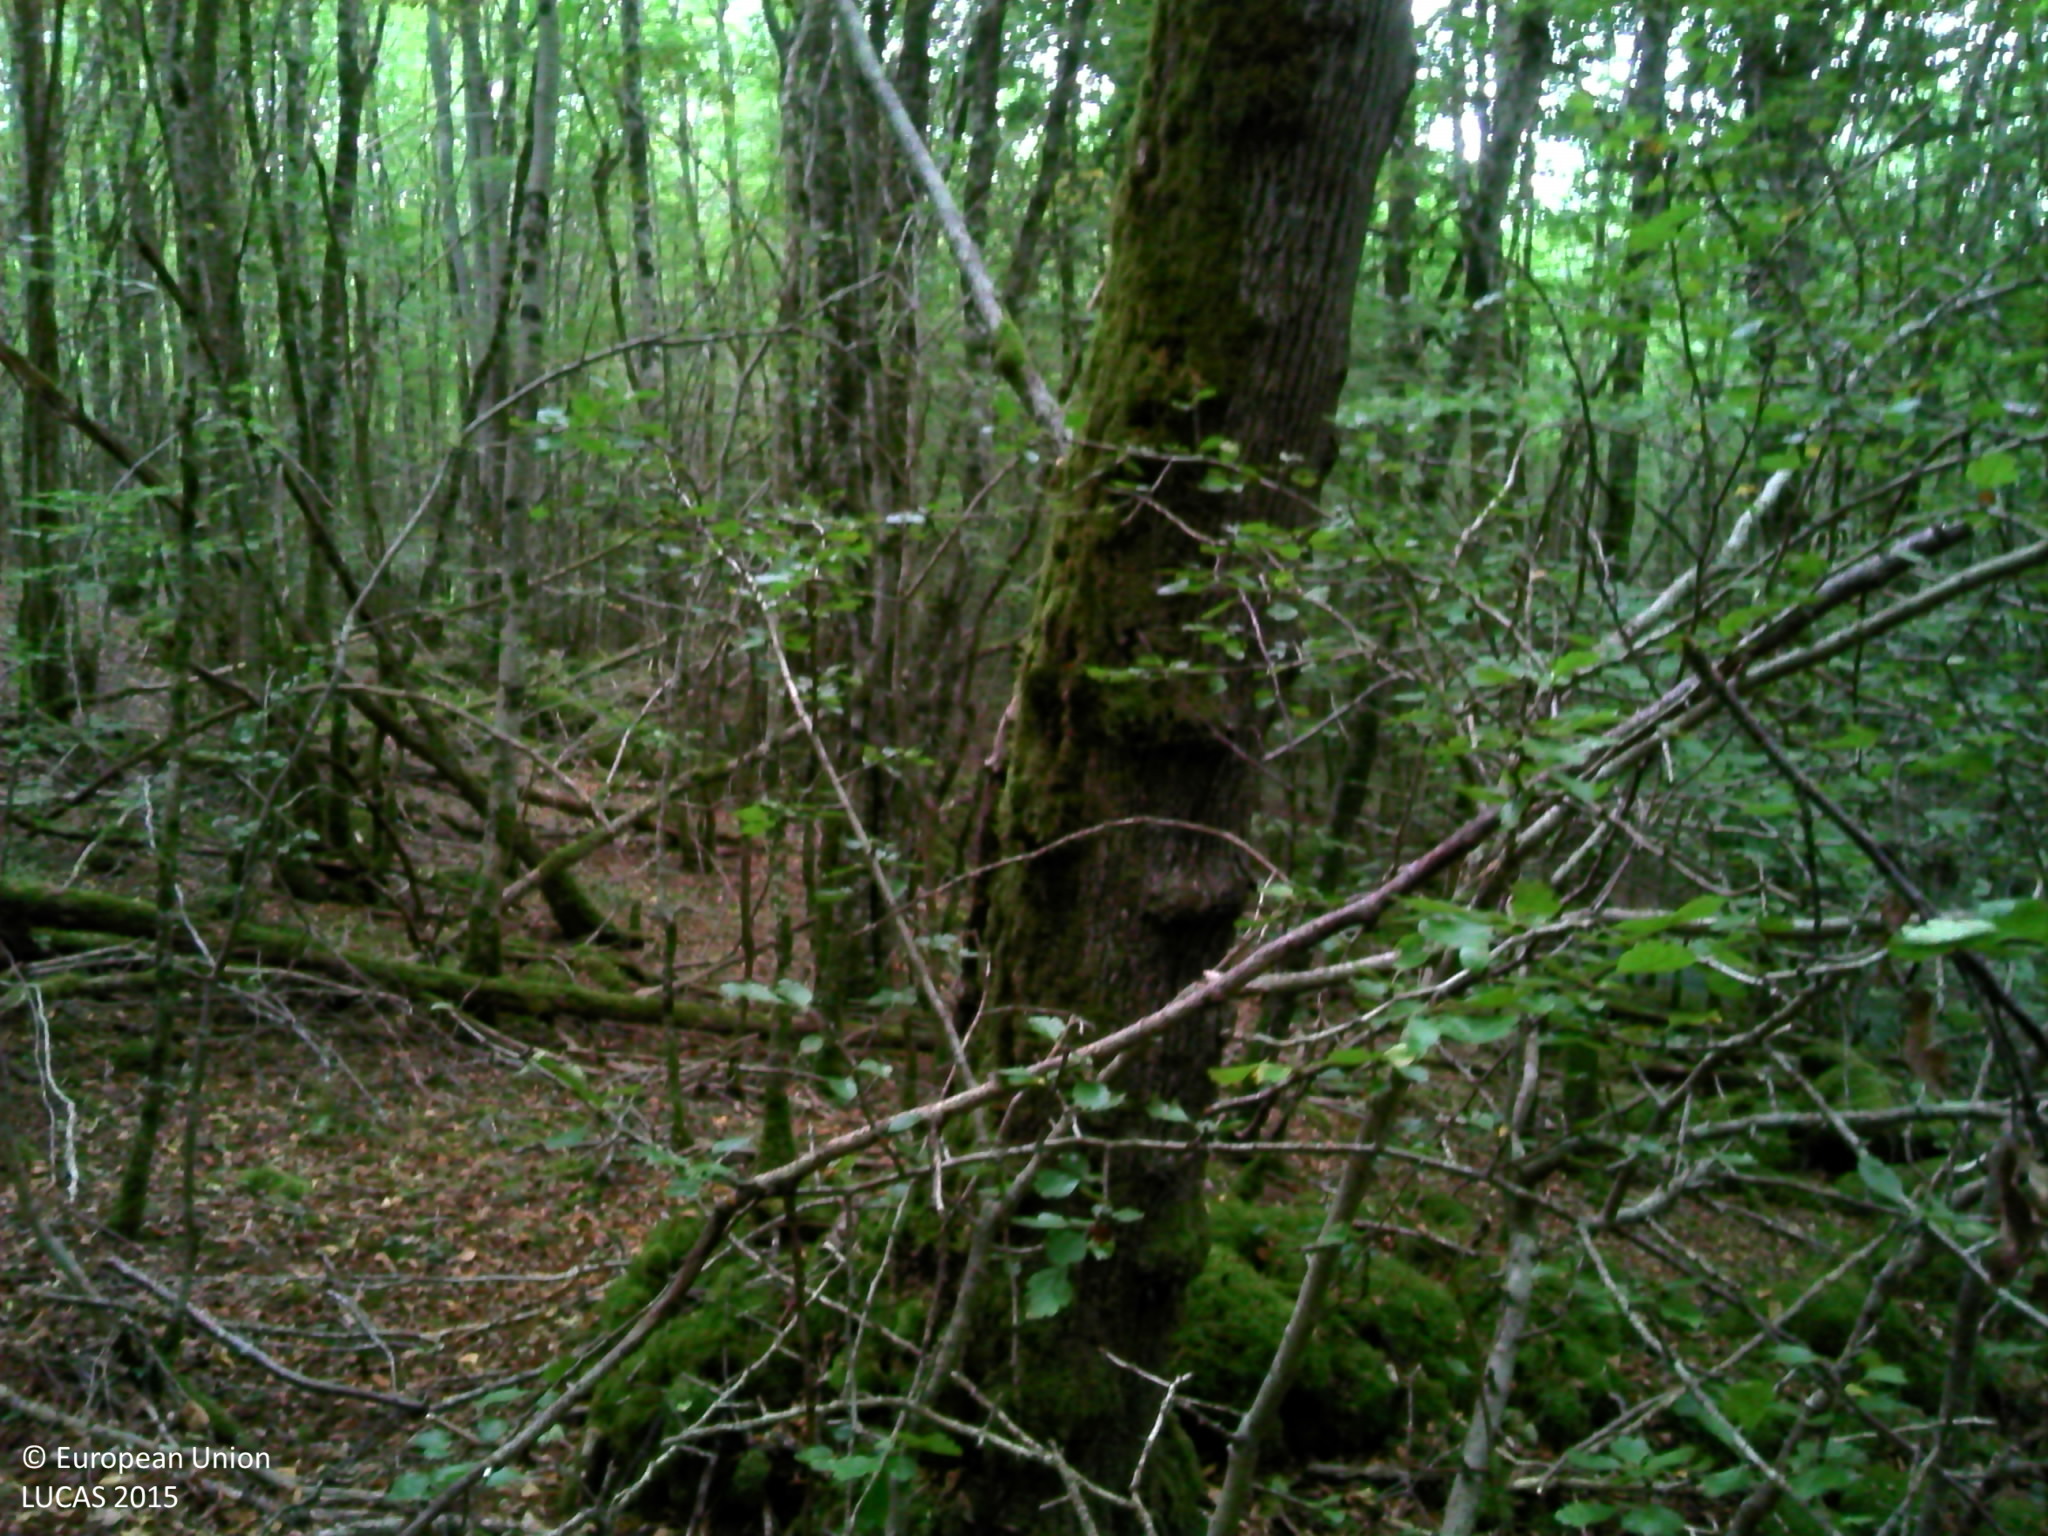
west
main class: Woodland
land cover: Broadleaved woodland
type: mesophytic deciduous forest
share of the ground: > 75 %
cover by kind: broadleaved forest trees 90 %, herbaceous plants 5 %, lichens and mosses 5 %
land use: Forestry
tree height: > 5 m
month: August
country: FR
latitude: 47.7356
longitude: 4.7051
